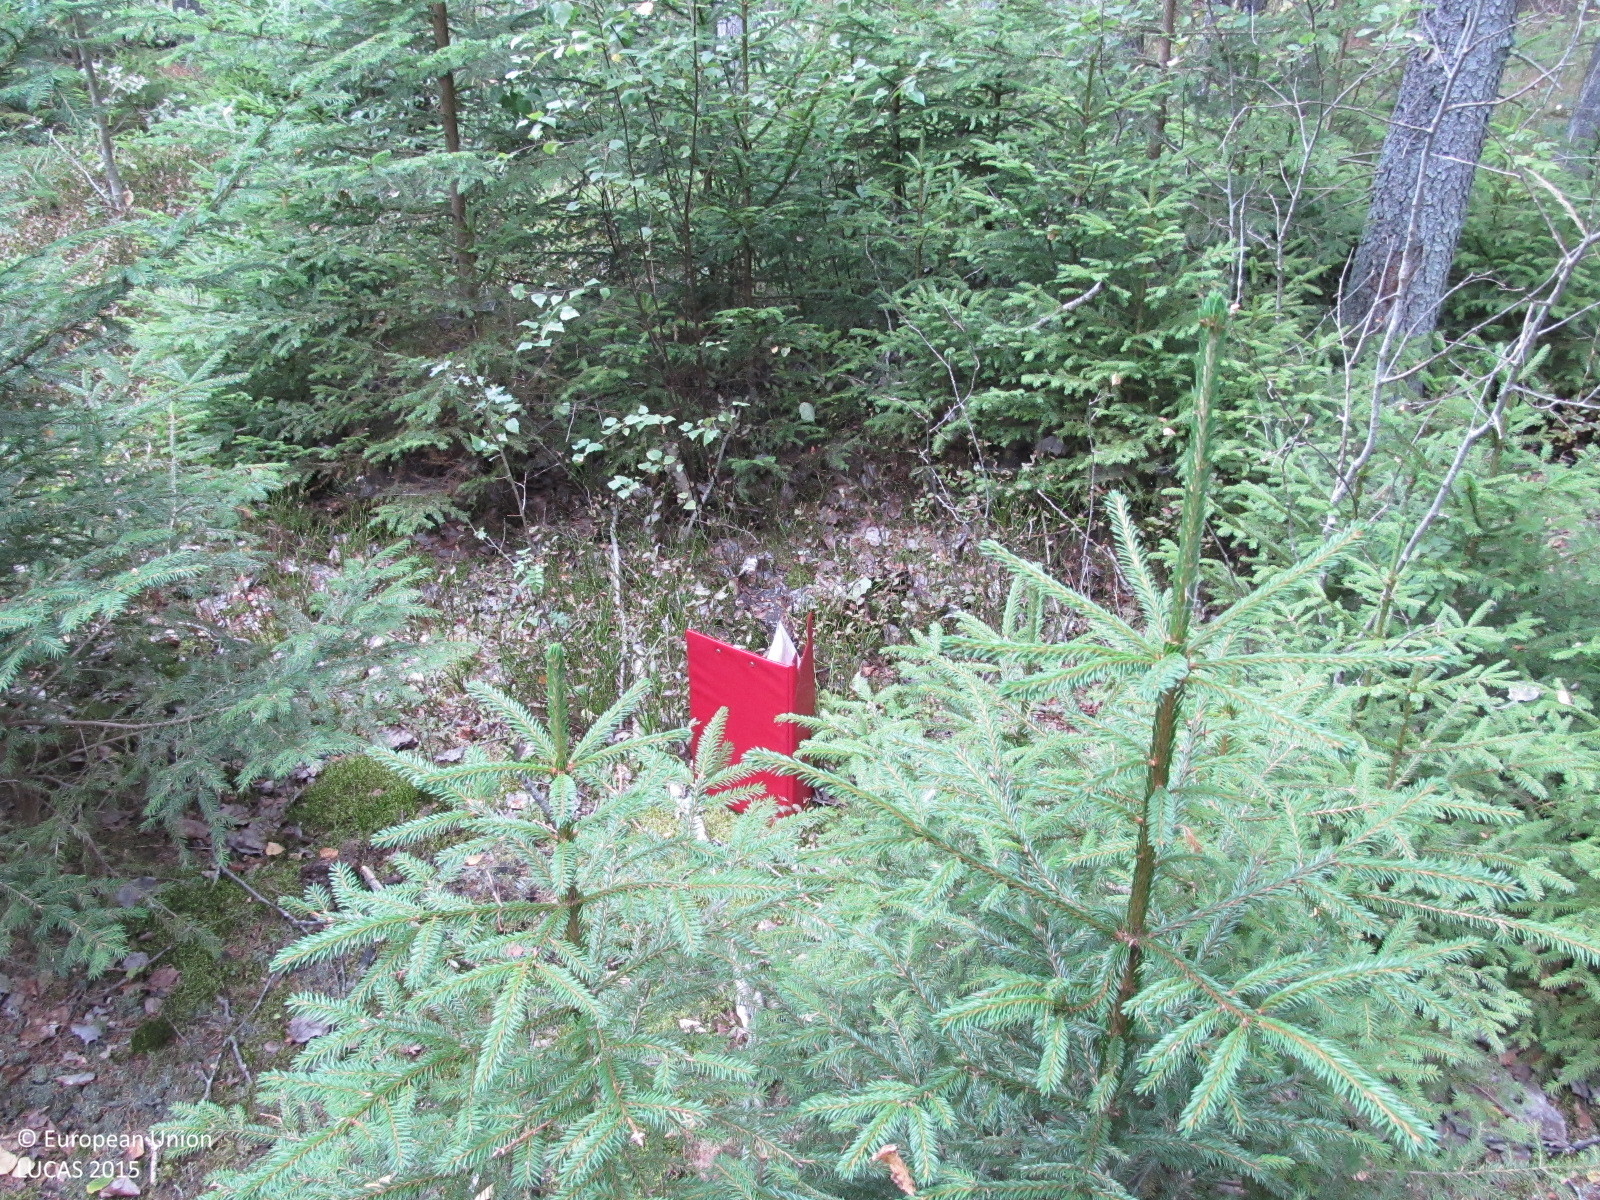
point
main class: Woodland
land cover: Spruce dominated mixed woodland
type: hemiboreal forest and nemoral coniferous forest and mixed broadleaved-coniferous forest
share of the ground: > 75 %
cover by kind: coniferous forest trees 50 %, broadleaved forest trees 30 %, shrubs 10 %, herbaceous plants 5 %, lichens and mosses 5 %
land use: Forestry
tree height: > 5 m
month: August
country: LT
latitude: 55.6516
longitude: 22.9890
